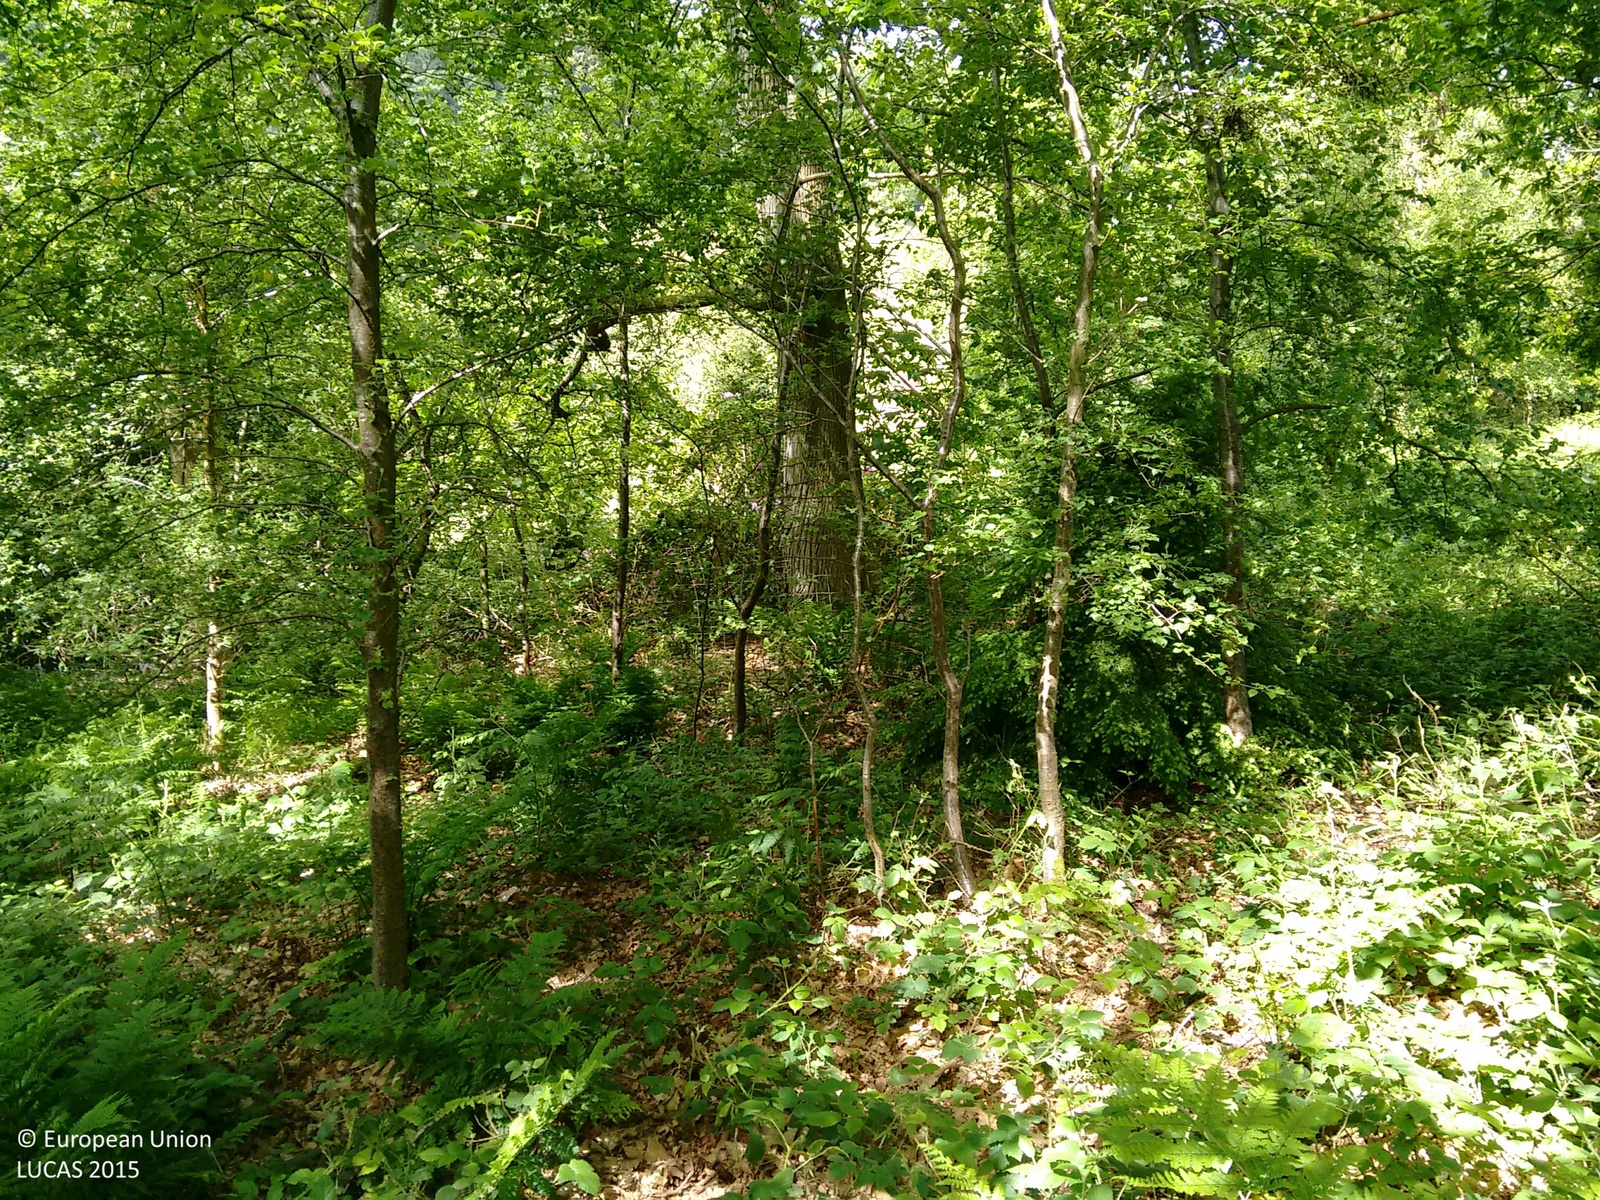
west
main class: Woodland
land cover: Broadleaved woodland
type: exotic forest
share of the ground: > 75 %
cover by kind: broadleaved forest trees 90 %, herbaceous plants 10 %
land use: Semi-natural and natural areas not in use
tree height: > 5 m
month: June
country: GB
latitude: 51.1126
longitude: -2.3339
